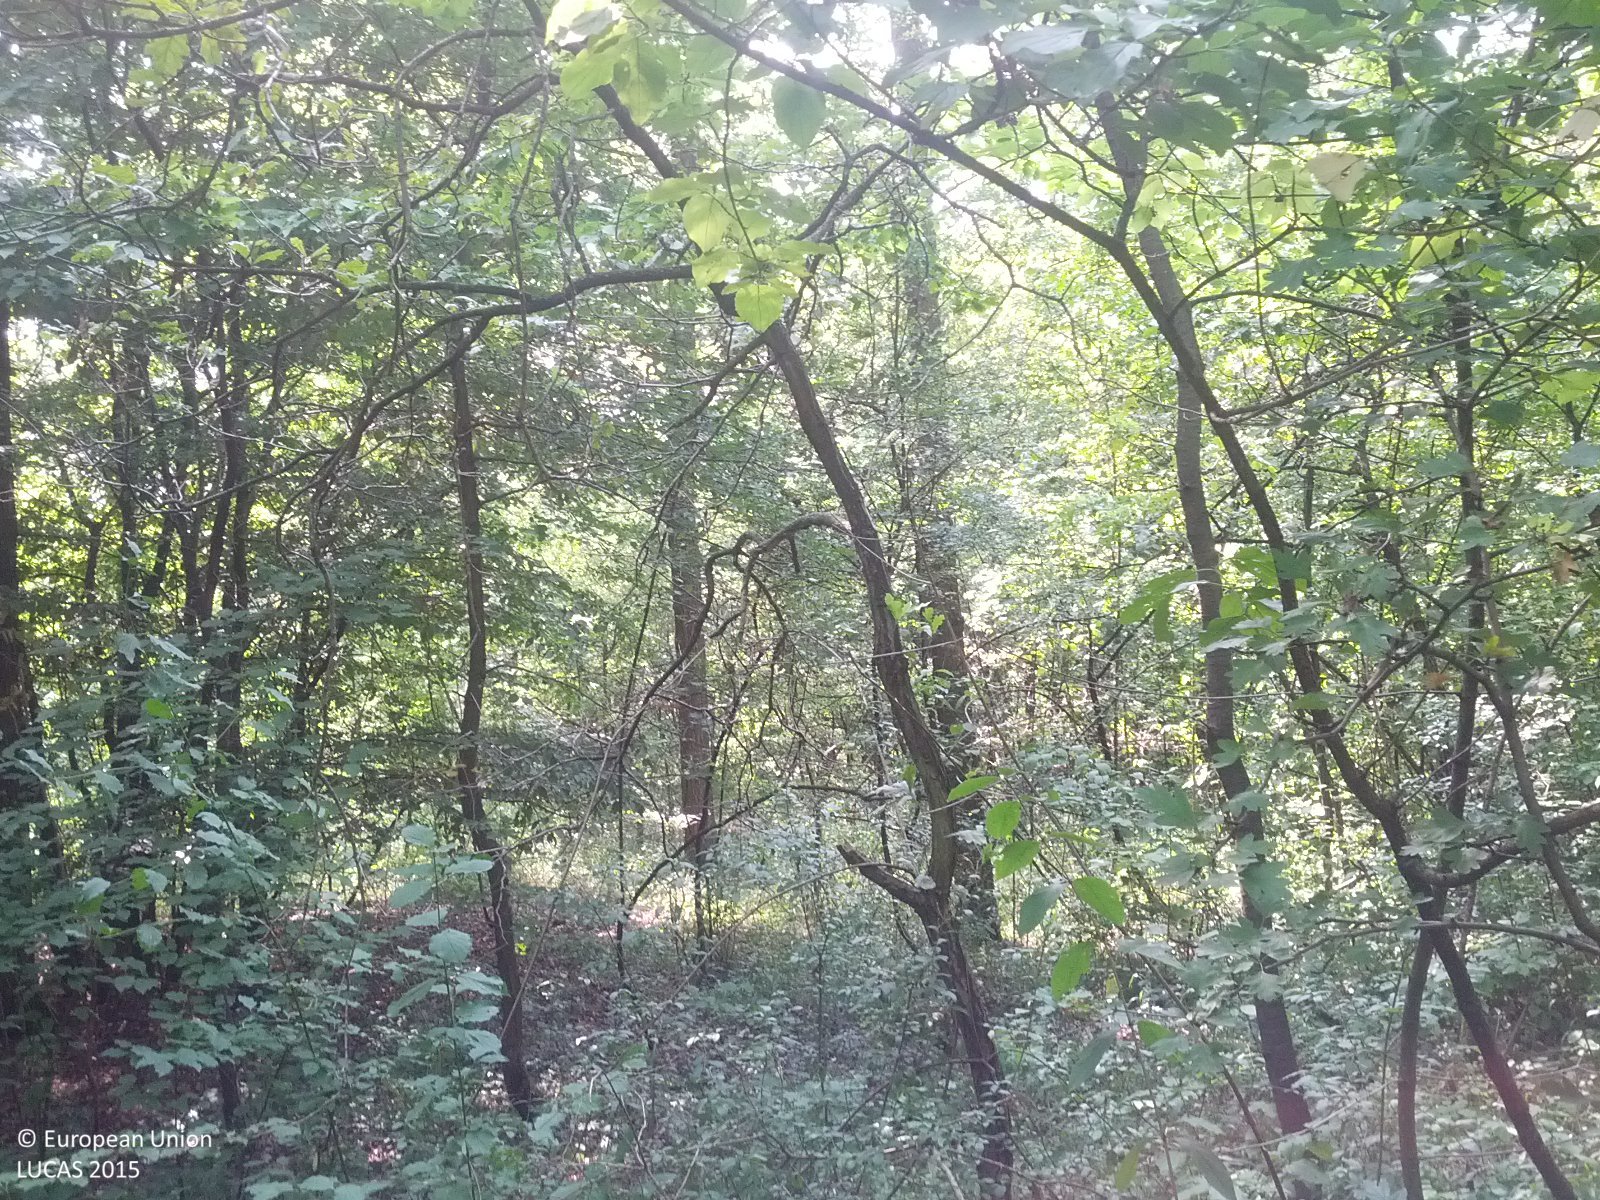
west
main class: Woodland
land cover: Broadleaved woodland
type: acidophilous oak and oak-birch forest
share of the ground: > 75 %
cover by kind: broadleaved forest trees 80 %, herbaceous plants 15 %, shrubs 5 %
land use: Forestry
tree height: > 5 m
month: July
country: AT
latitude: 48.3856
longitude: 16.3112
